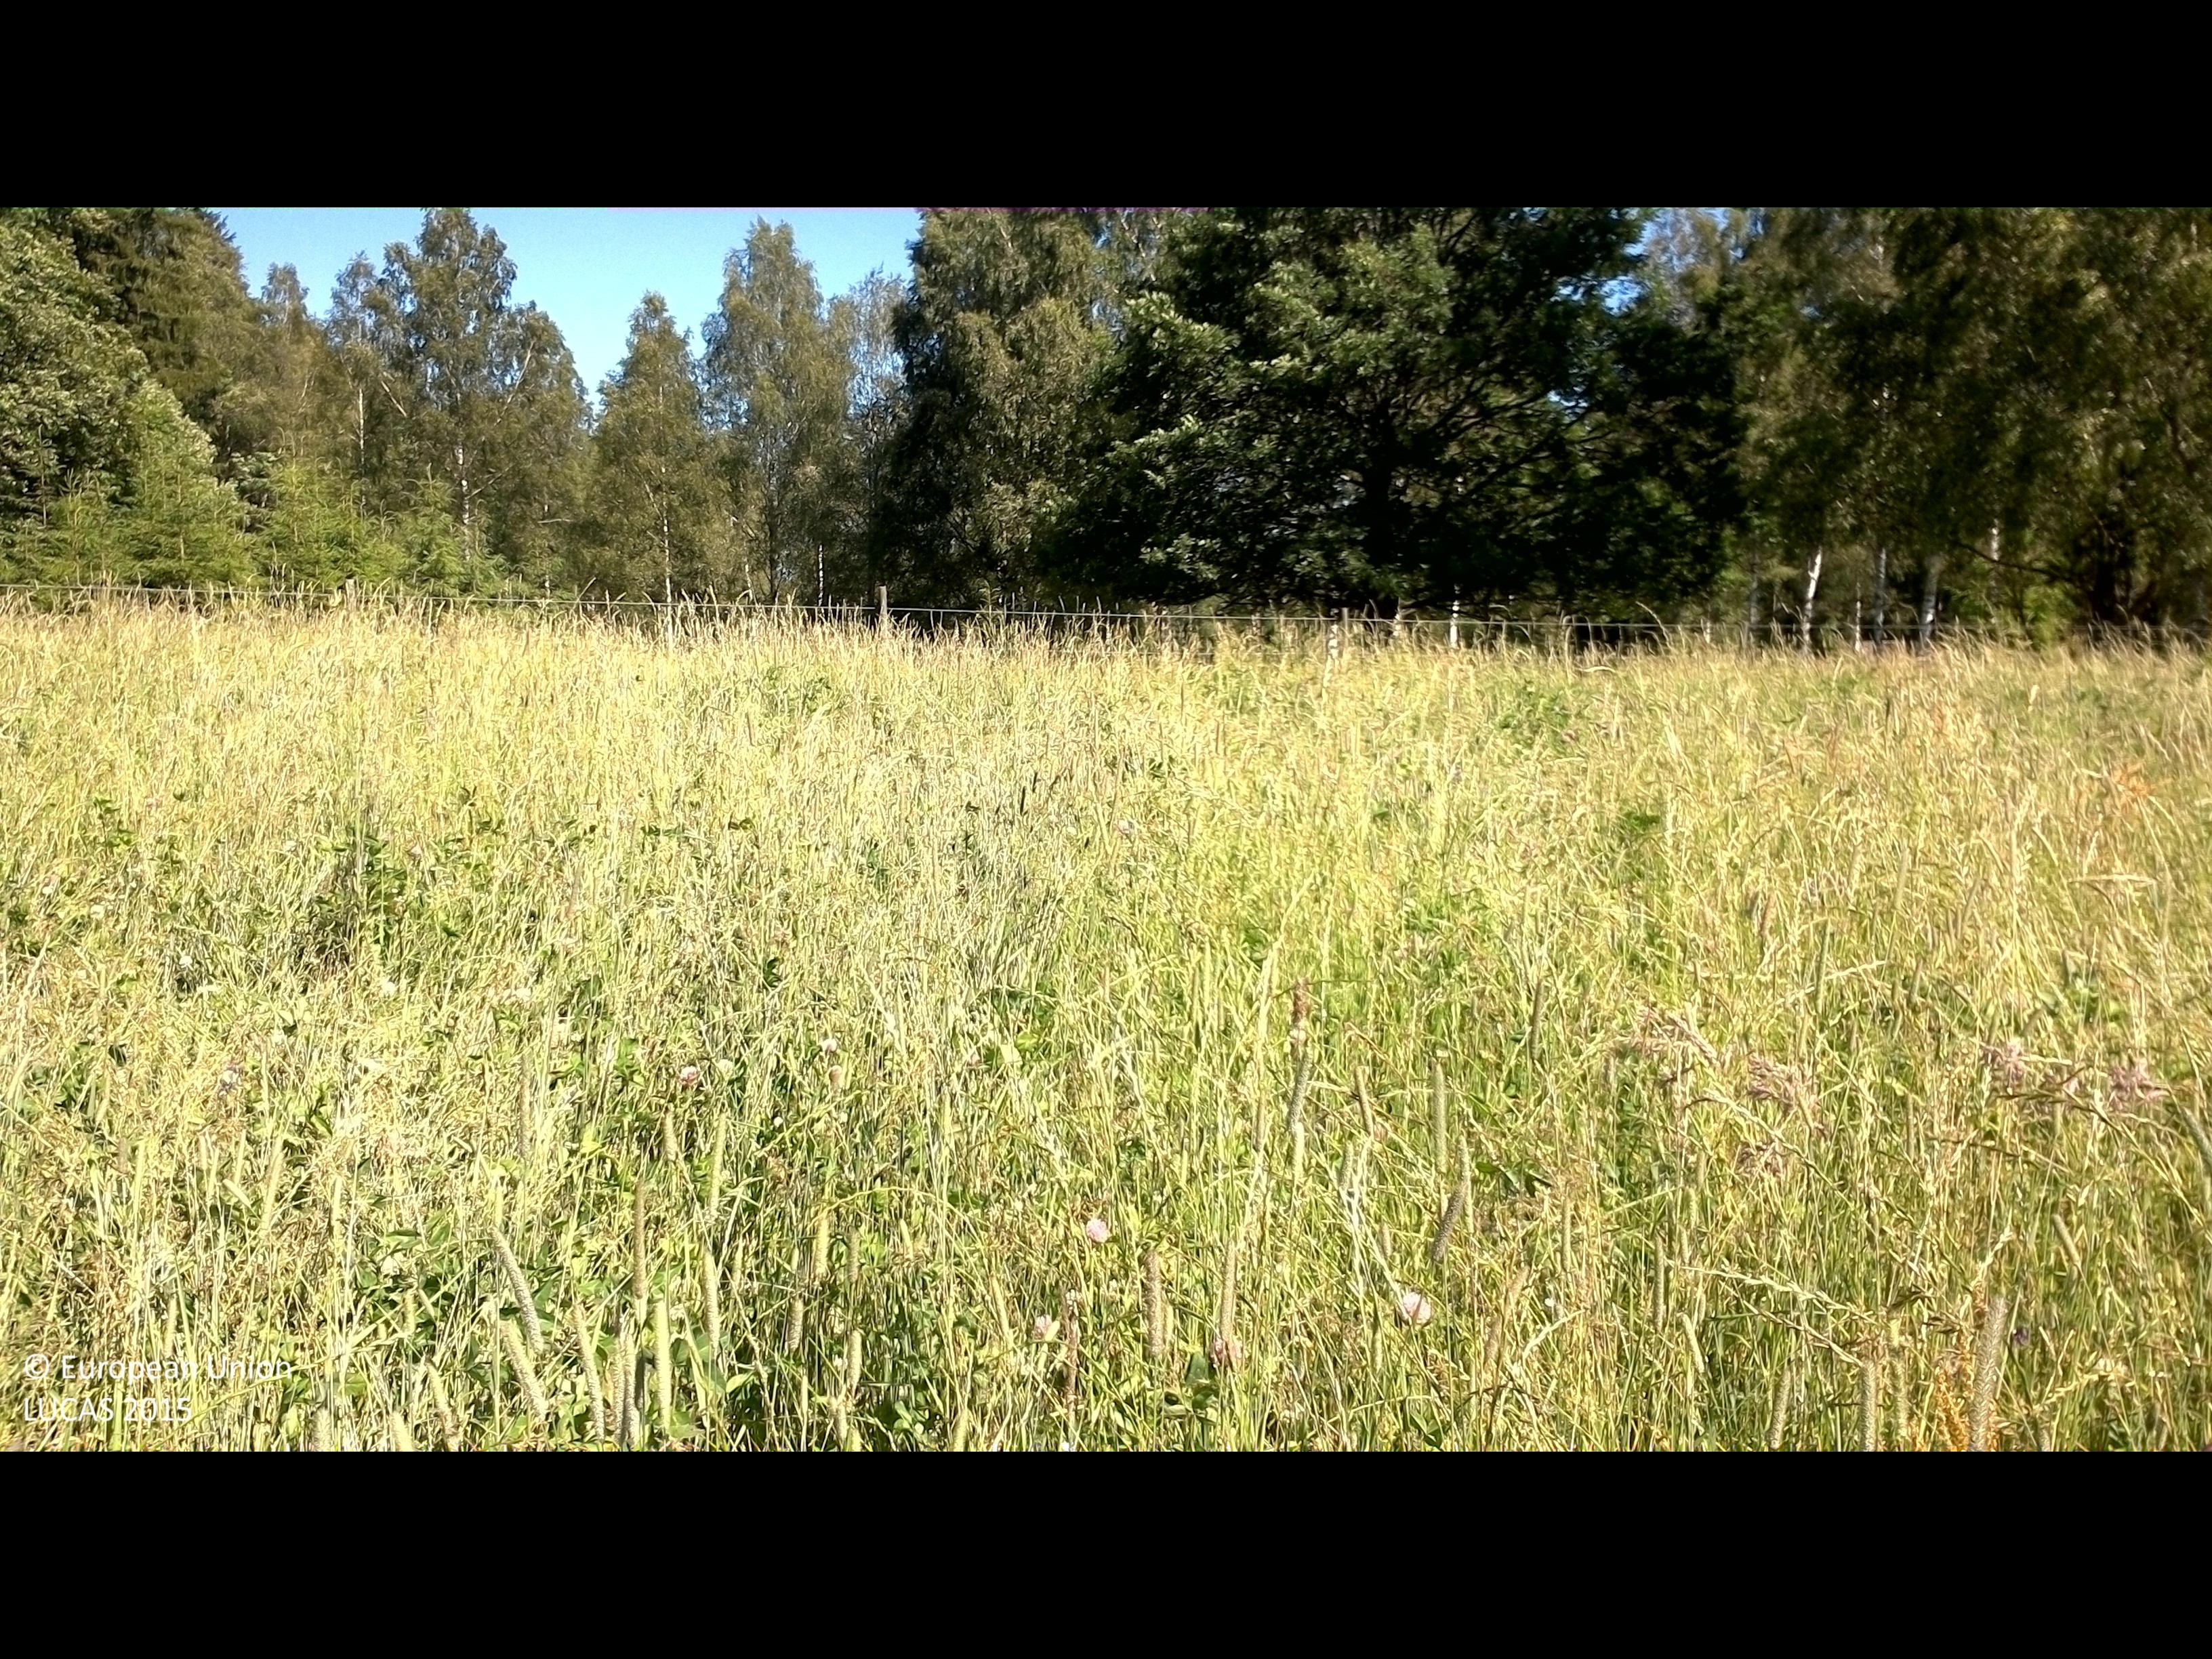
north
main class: Grassland
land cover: Grassland without tree/shrub cover
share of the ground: > 75 %
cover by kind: herbaceous plants 100 %
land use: Agriculture (excluding fallow land and kitchen gardens)
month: July
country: SE
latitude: 56.5114
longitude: 14.8241
